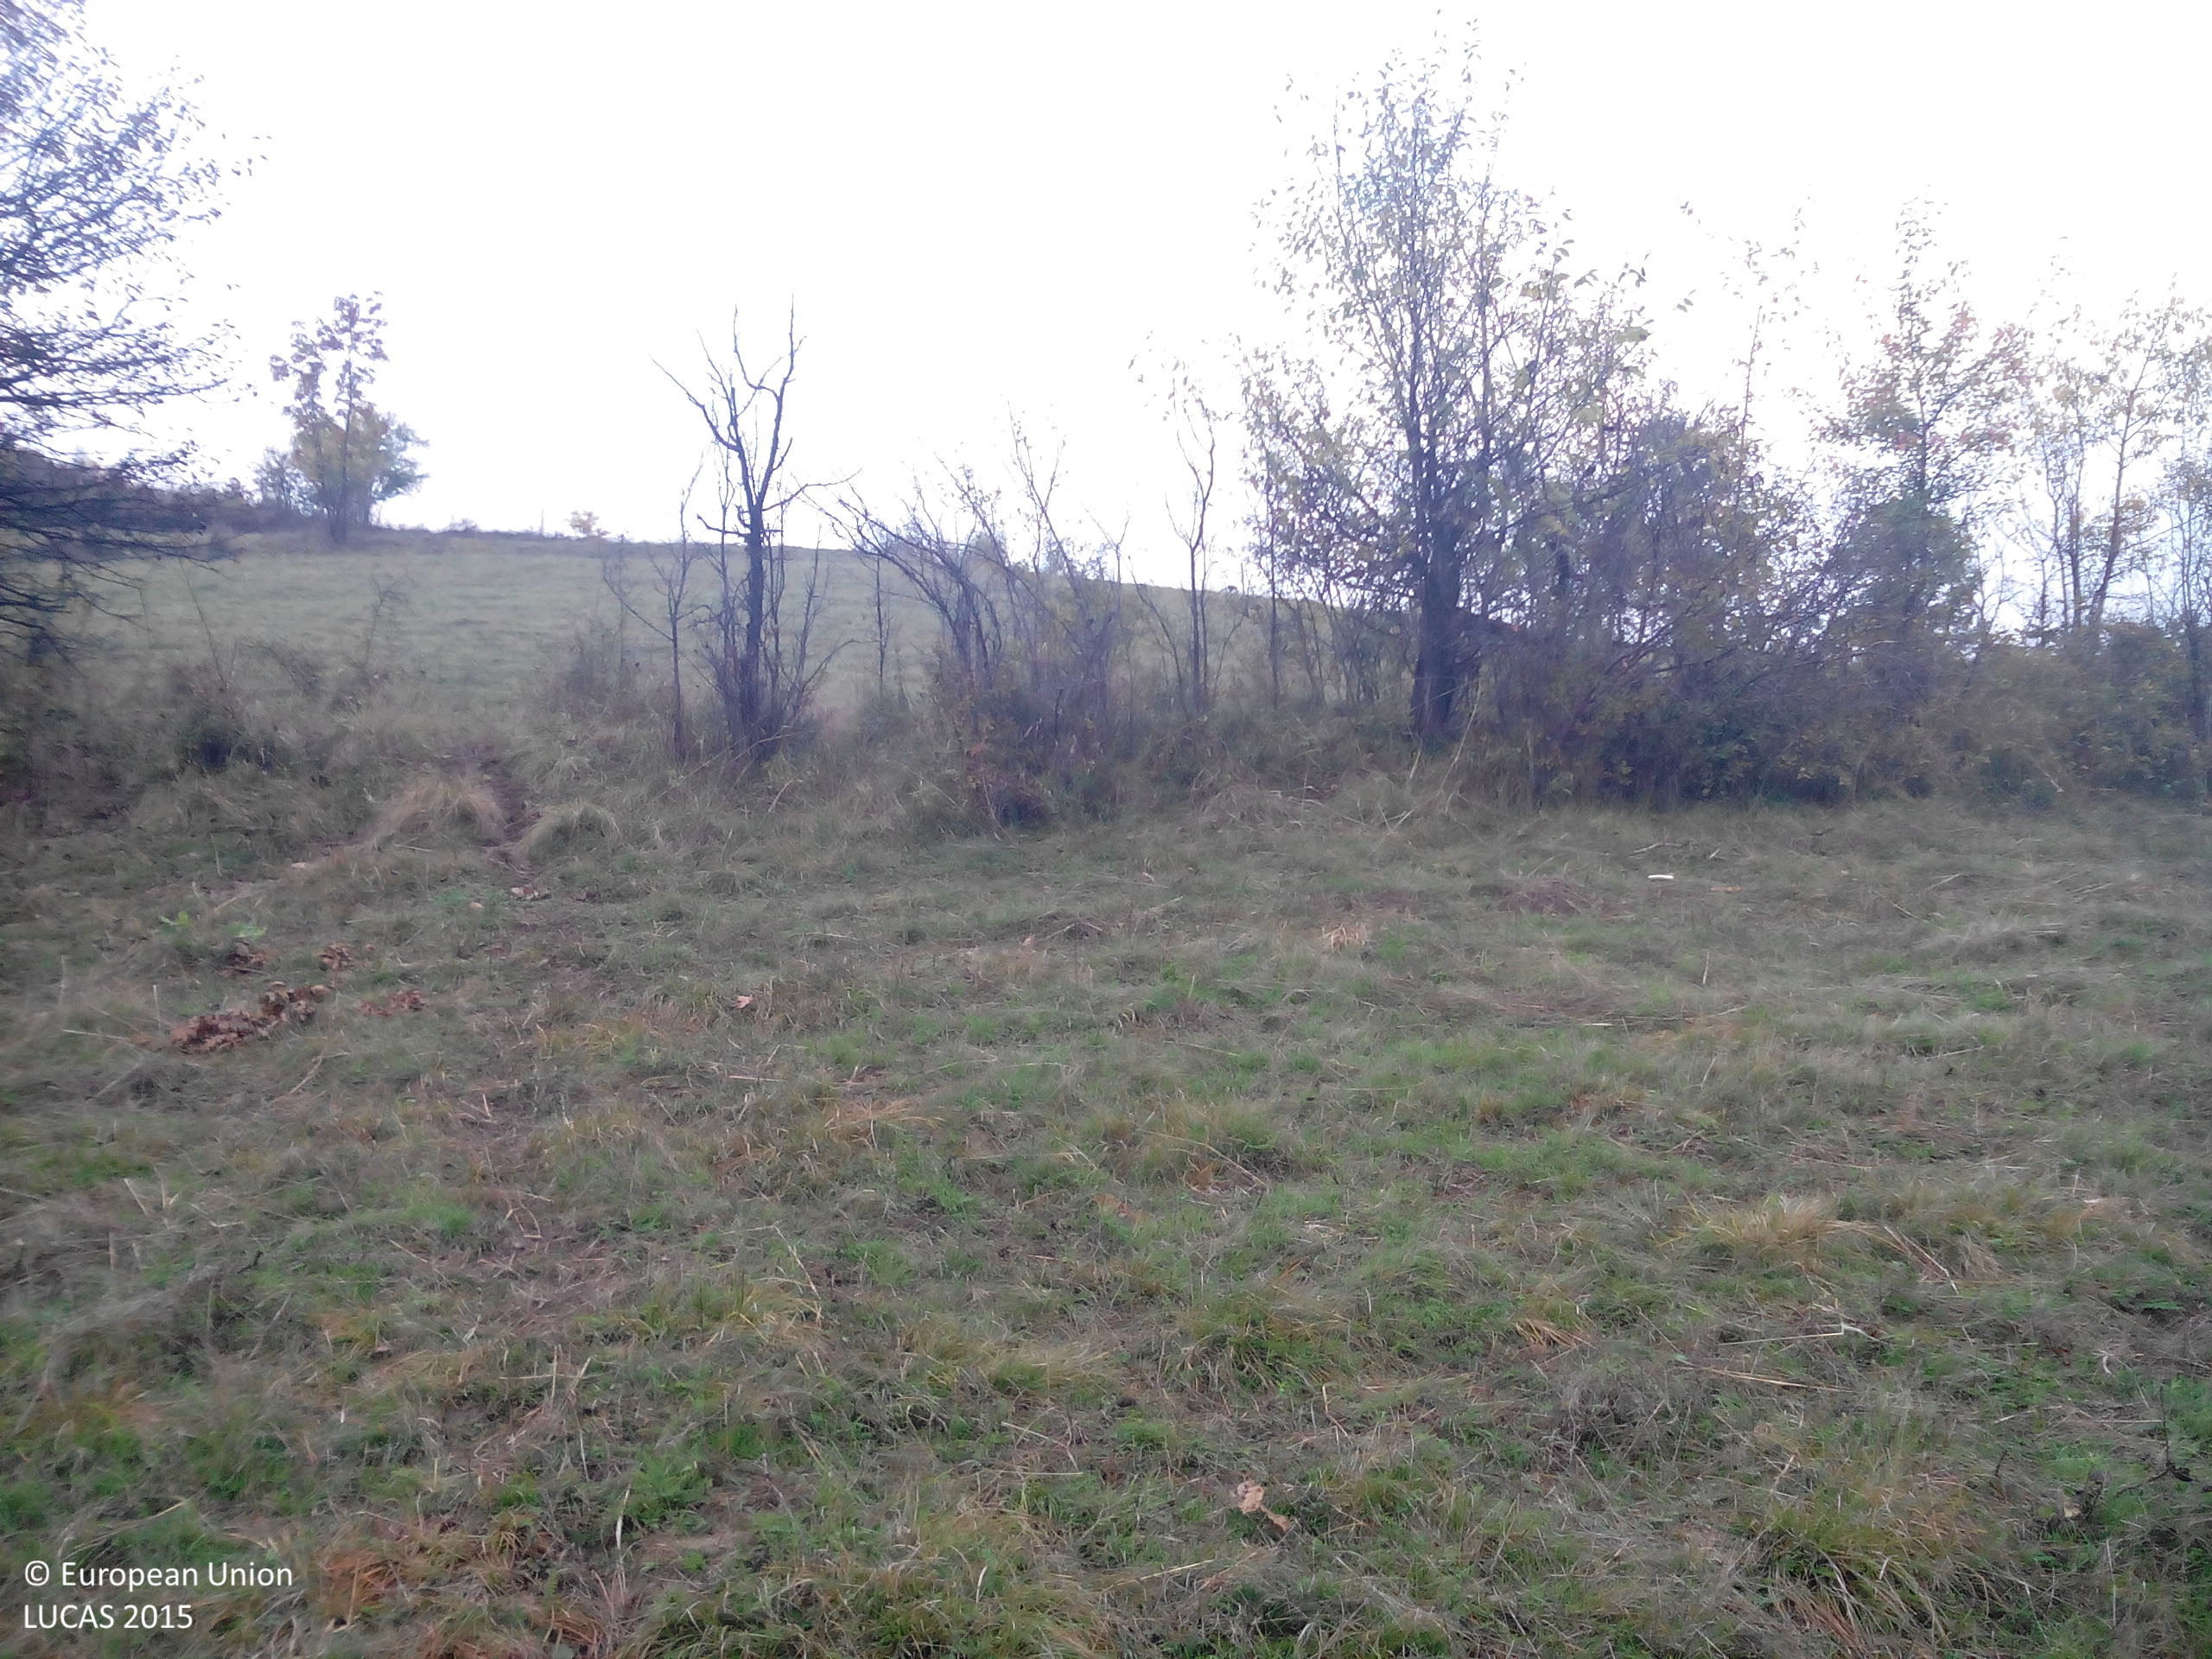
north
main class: Grassland
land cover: Grassland without tree/shrub cover
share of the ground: > 75 %
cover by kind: herbaceous plants 100 %
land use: Agriculture (excluding fallow land and kitchen gardens)
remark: Harvested field
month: October
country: BG
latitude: 42.9237
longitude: 23.9767
